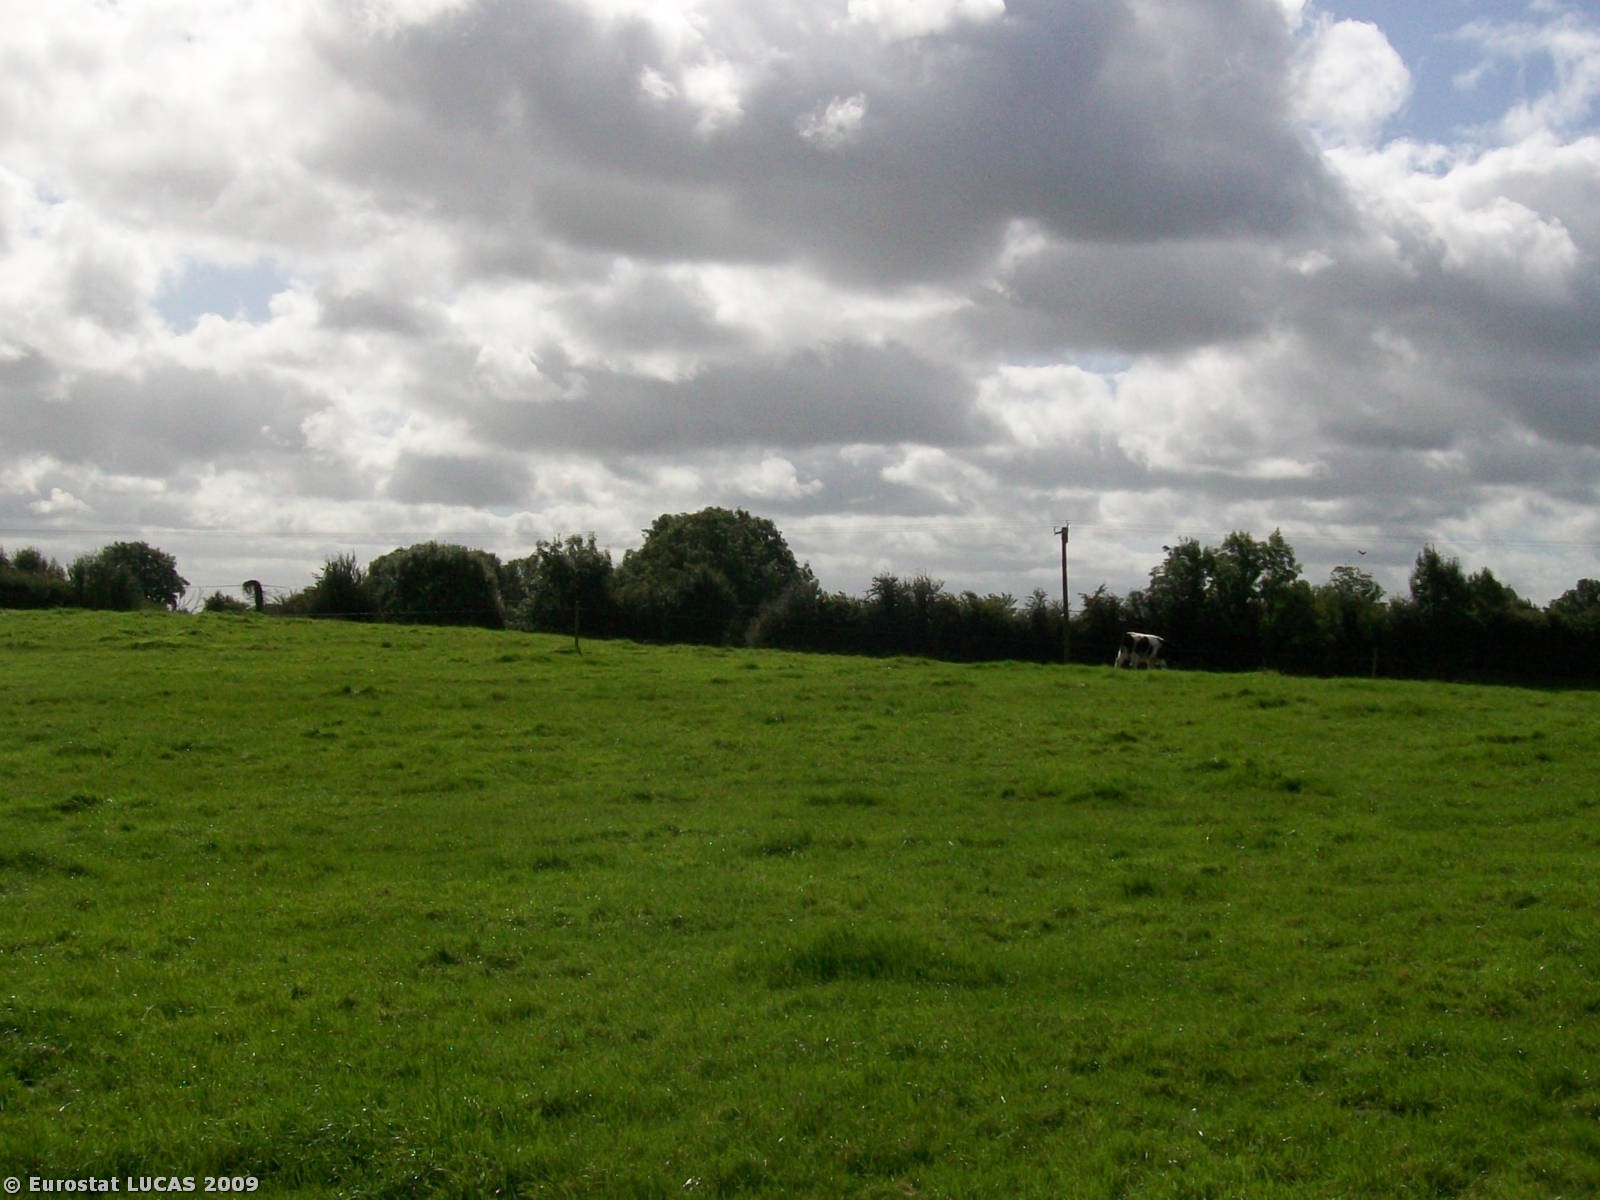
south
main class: Grassland
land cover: Grassland without tree/shrub cover
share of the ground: > 75 %
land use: Agriculture (excluding fallow land and kitchen gardens)
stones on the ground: < 10 %
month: September
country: IE
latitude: 53.1248
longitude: -7.8797
